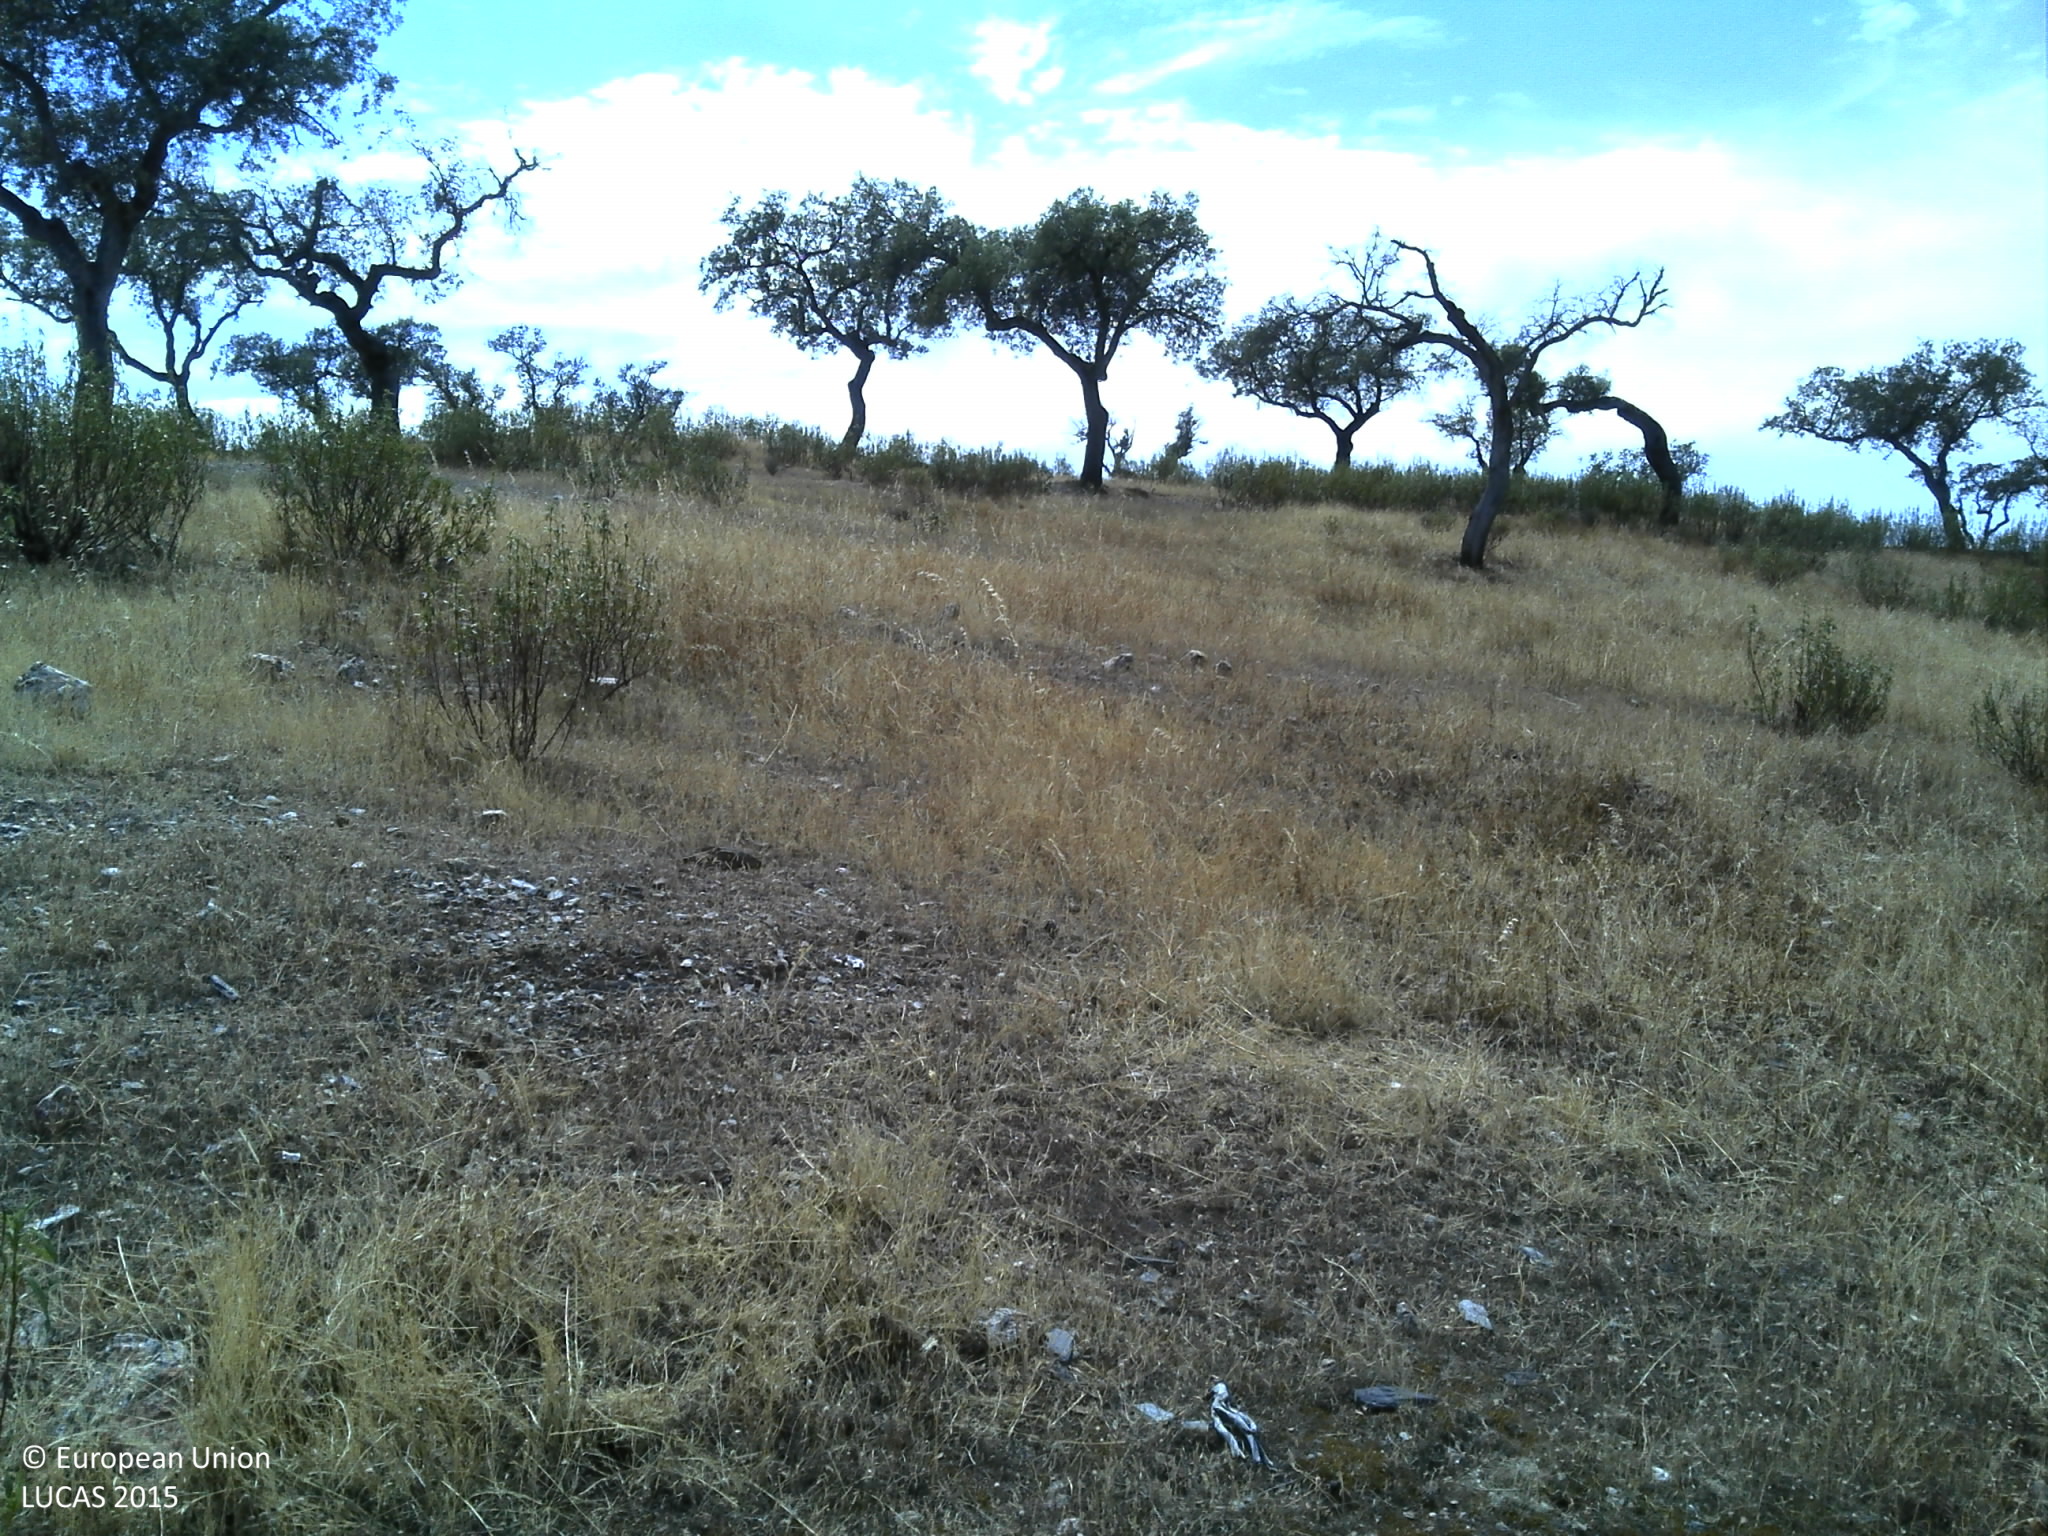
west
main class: Grassland
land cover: Grassland with sparse tree/shrub cover
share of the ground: 50 - 75 %
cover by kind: herbaceous plants 60 %, unconsolidated bare surface 30 %, broadleaved forest trees 5 %, shrubs 5 %
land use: Agriculture (excluding fallow land and kitchen gardens)
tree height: < 5 m
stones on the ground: < 10 %
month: July
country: PT
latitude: 38.1156
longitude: -7.1570
